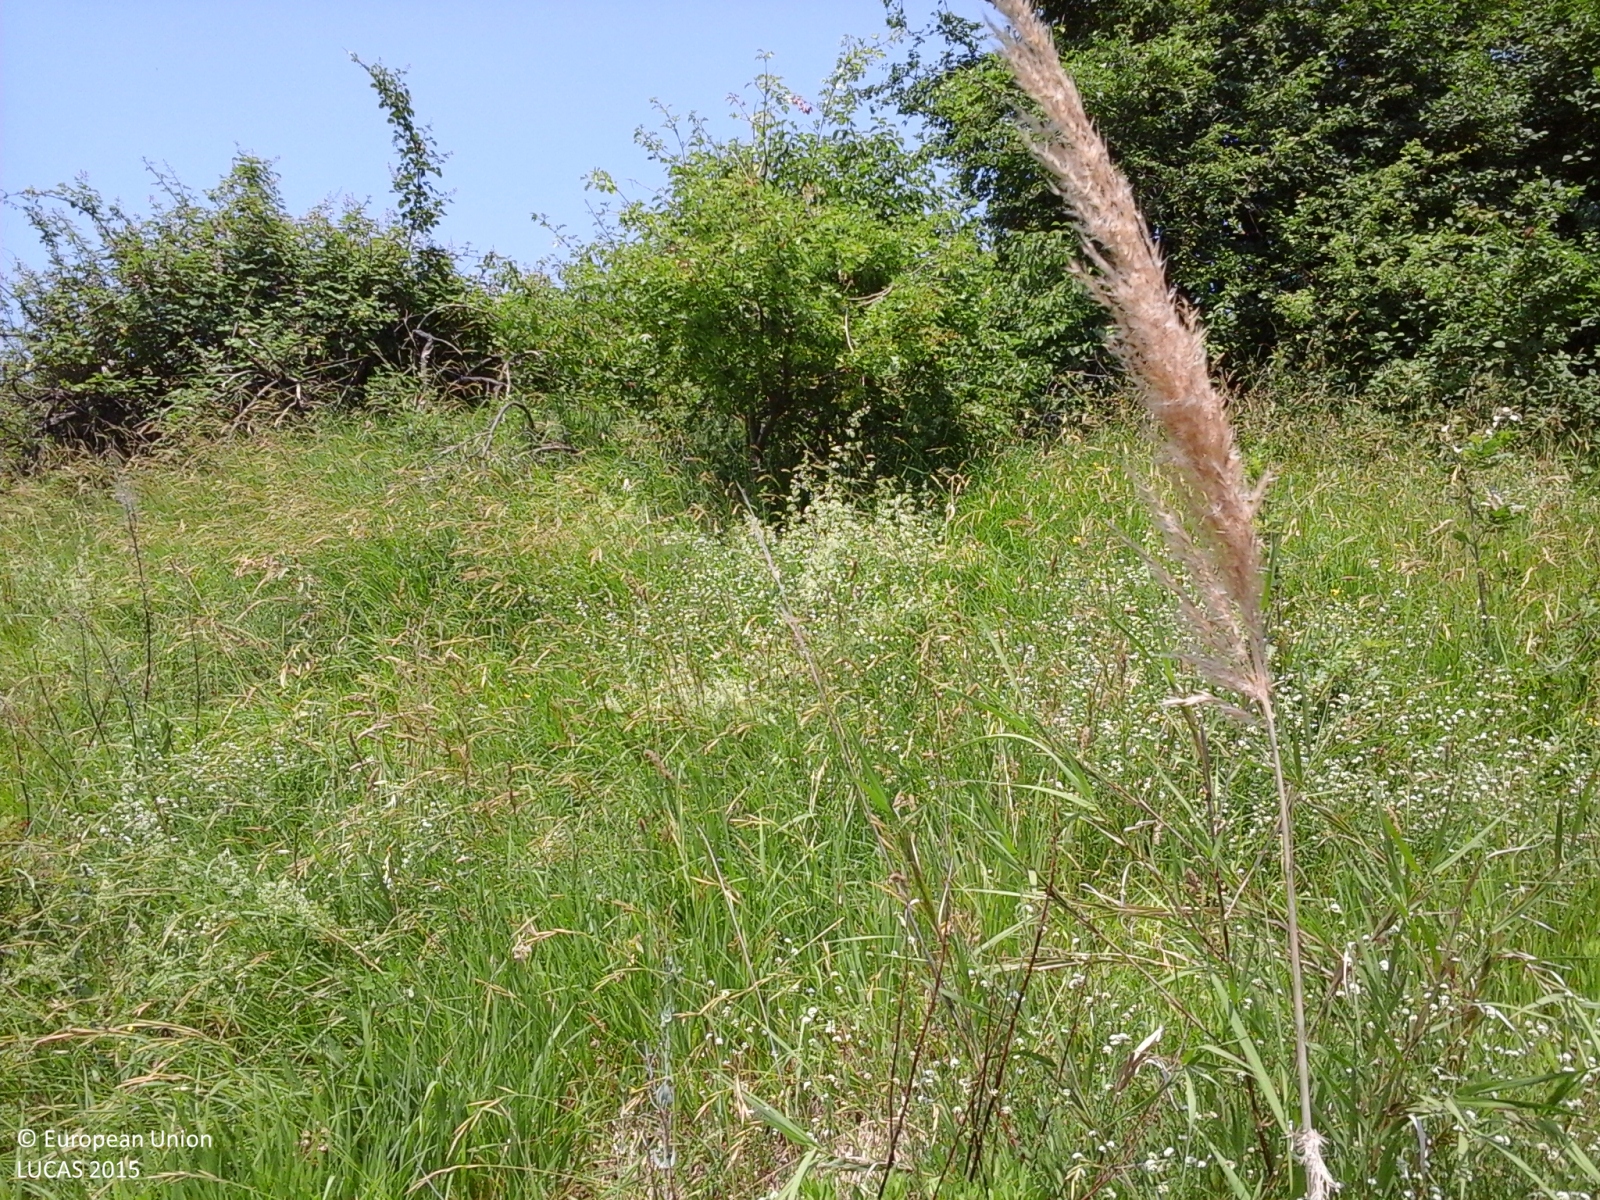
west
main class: Shrubland
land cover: Shrubland with sparse tree cover
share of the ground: > 75 %
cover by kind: shrubs 70 %, herbaceous plants 25 %, broadleaved forest trees 5 %
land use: Semi-natural and natural areas not in use
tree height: < 5 m
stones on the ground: < 10 %
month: June
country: IT
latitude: 44.2067
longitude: 11.9103
